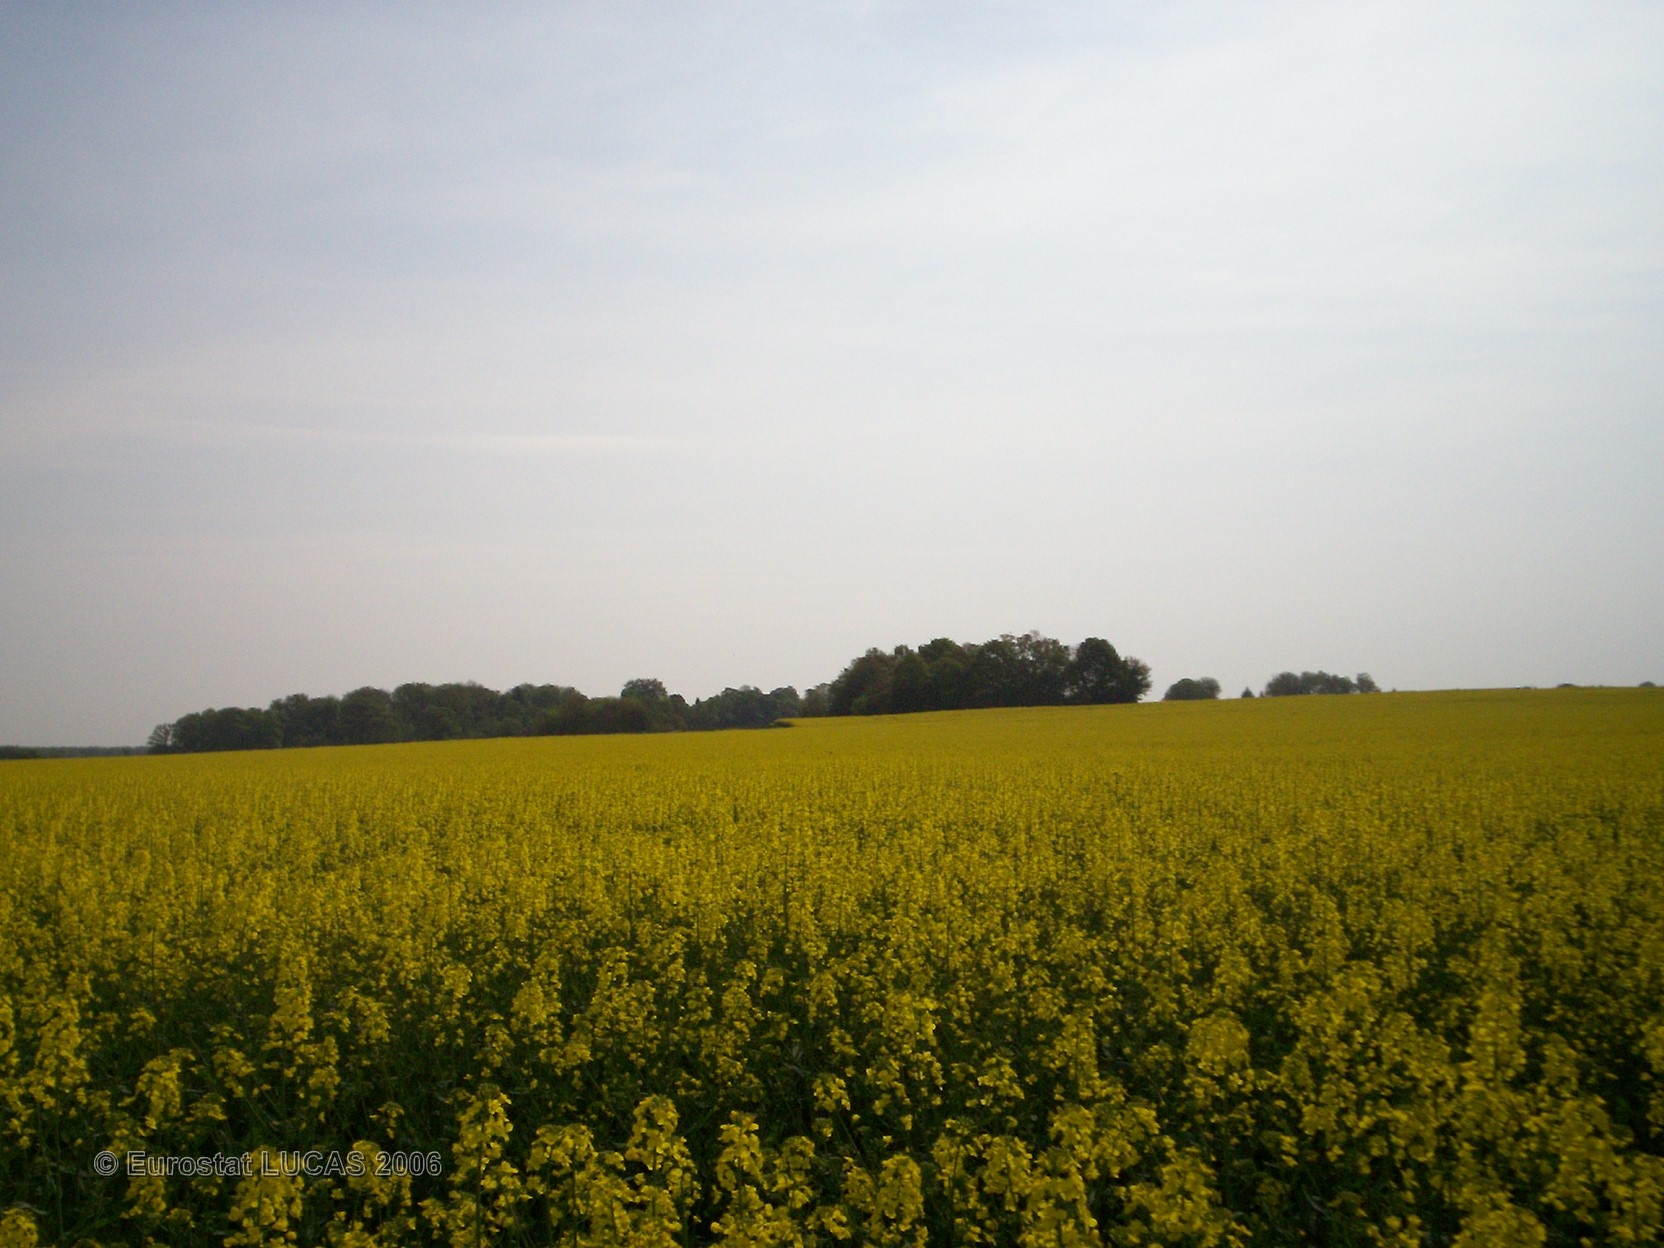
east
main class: Cropland
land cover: Rape and turnip rape
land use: Agriculture (excluding fallow land and kitchen gardens)
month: May
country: FR
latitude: 48.0859
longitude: 2.9175
